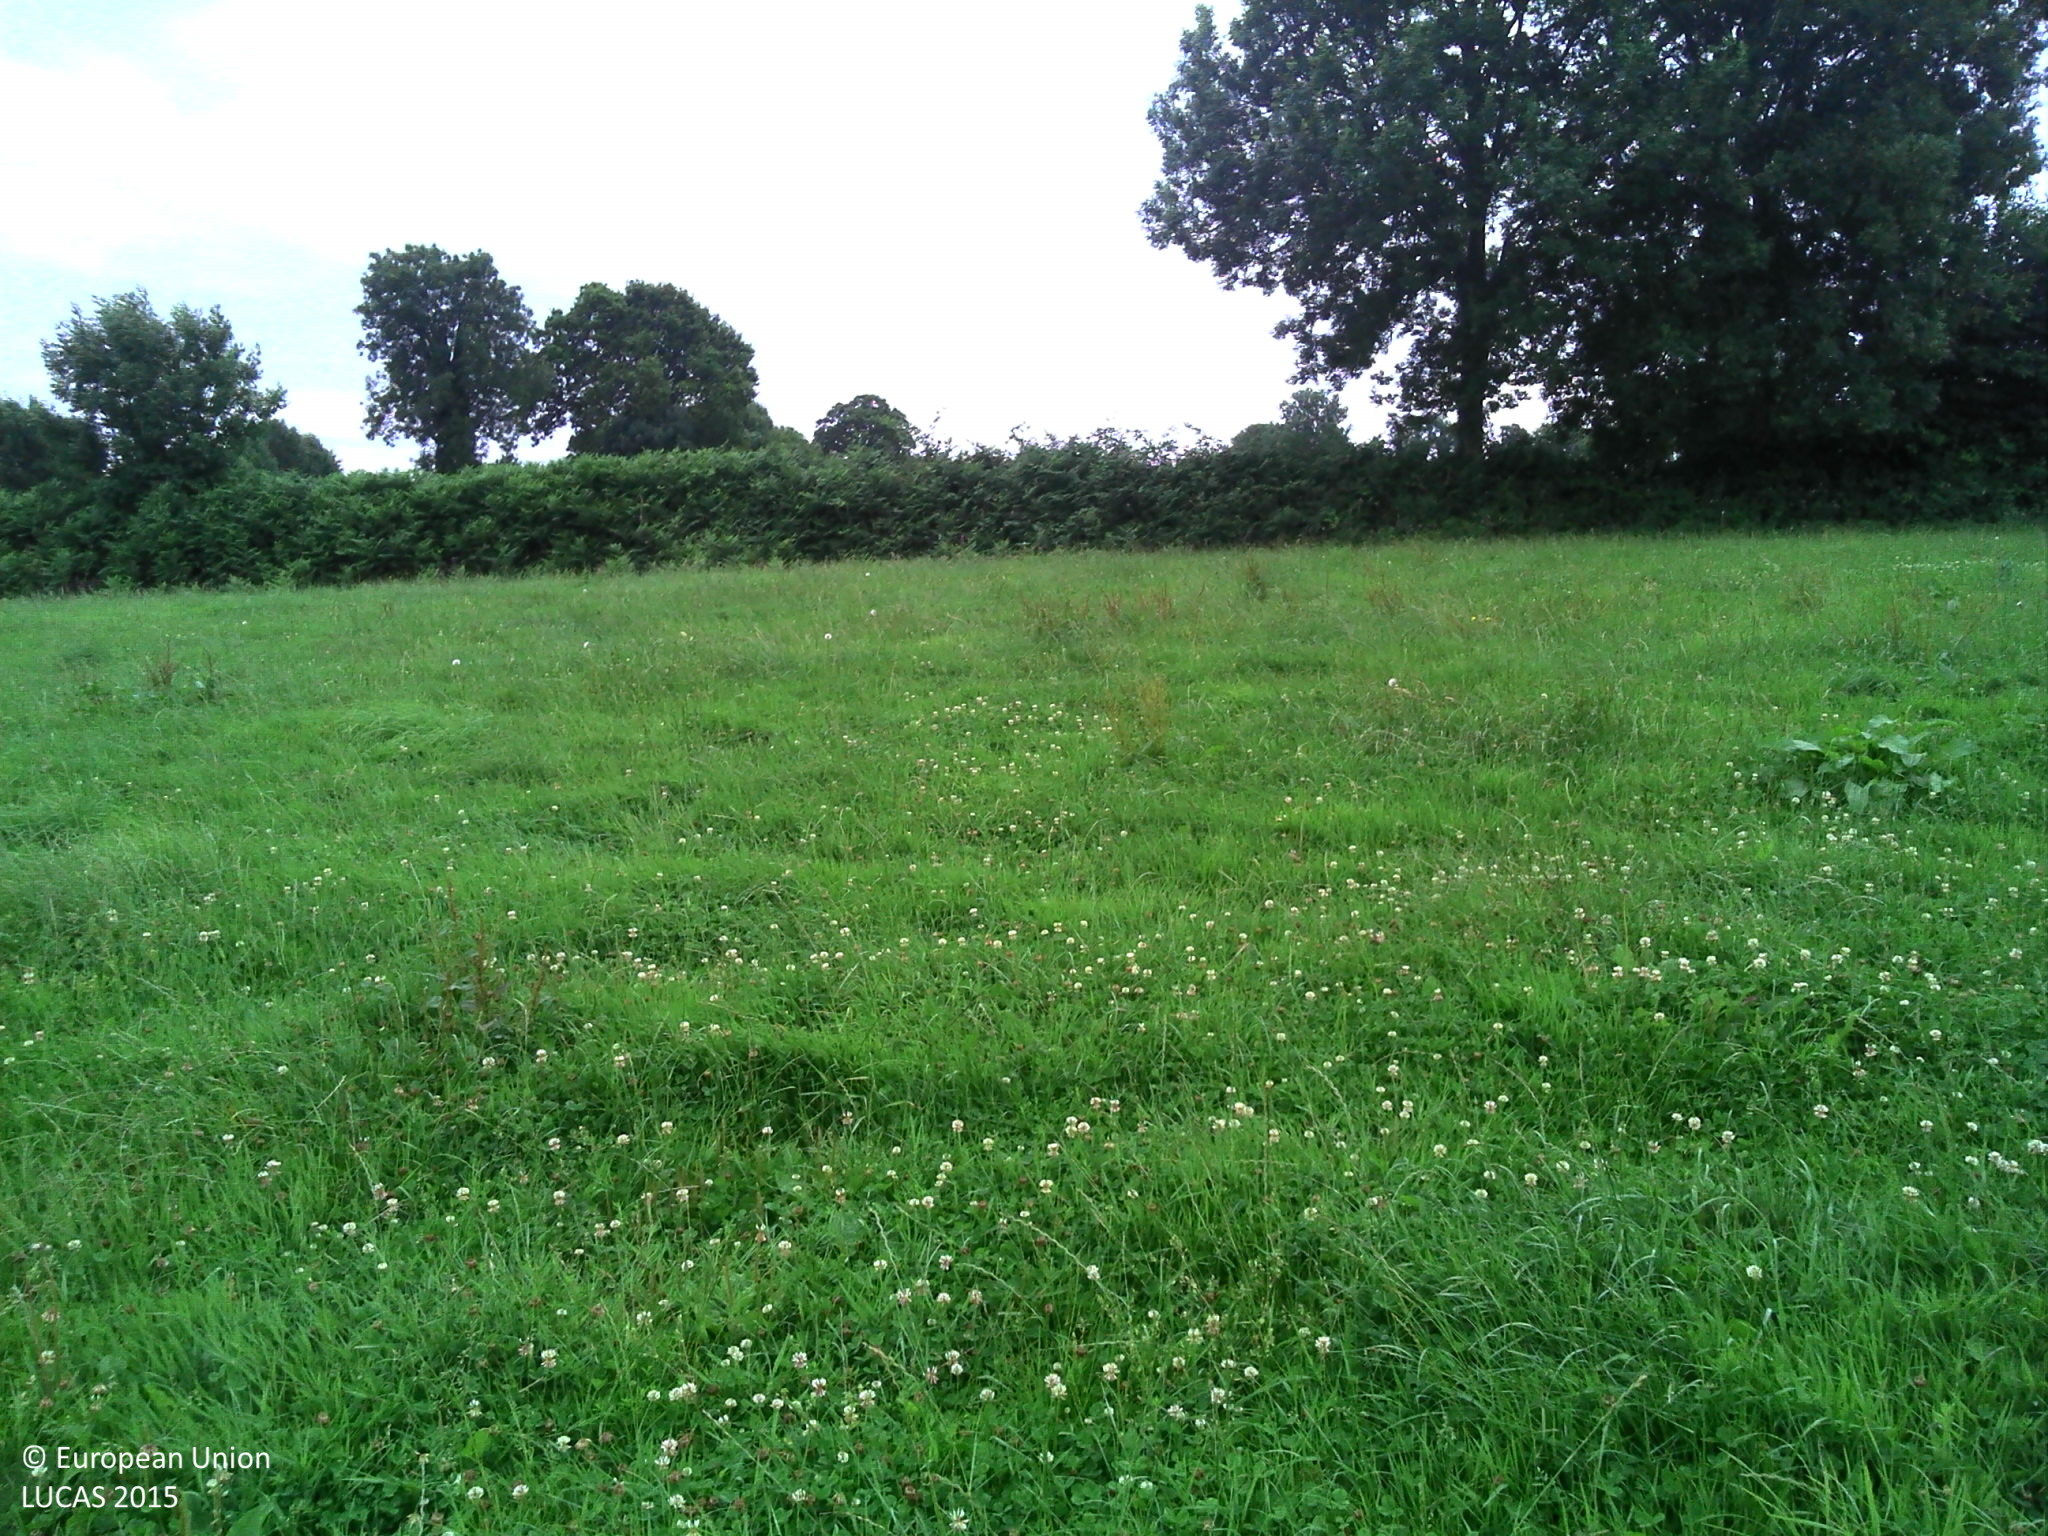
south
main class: Grassland
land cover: Grassland without tree/shrub cover
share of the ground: > 75 %
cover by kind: herbaceous plants 100 %
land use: Agriculture (excluding fallow land and kitchen gardens)
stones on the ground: < 10 %
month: July
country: FR
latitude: 48.8503
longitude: -1.3712
